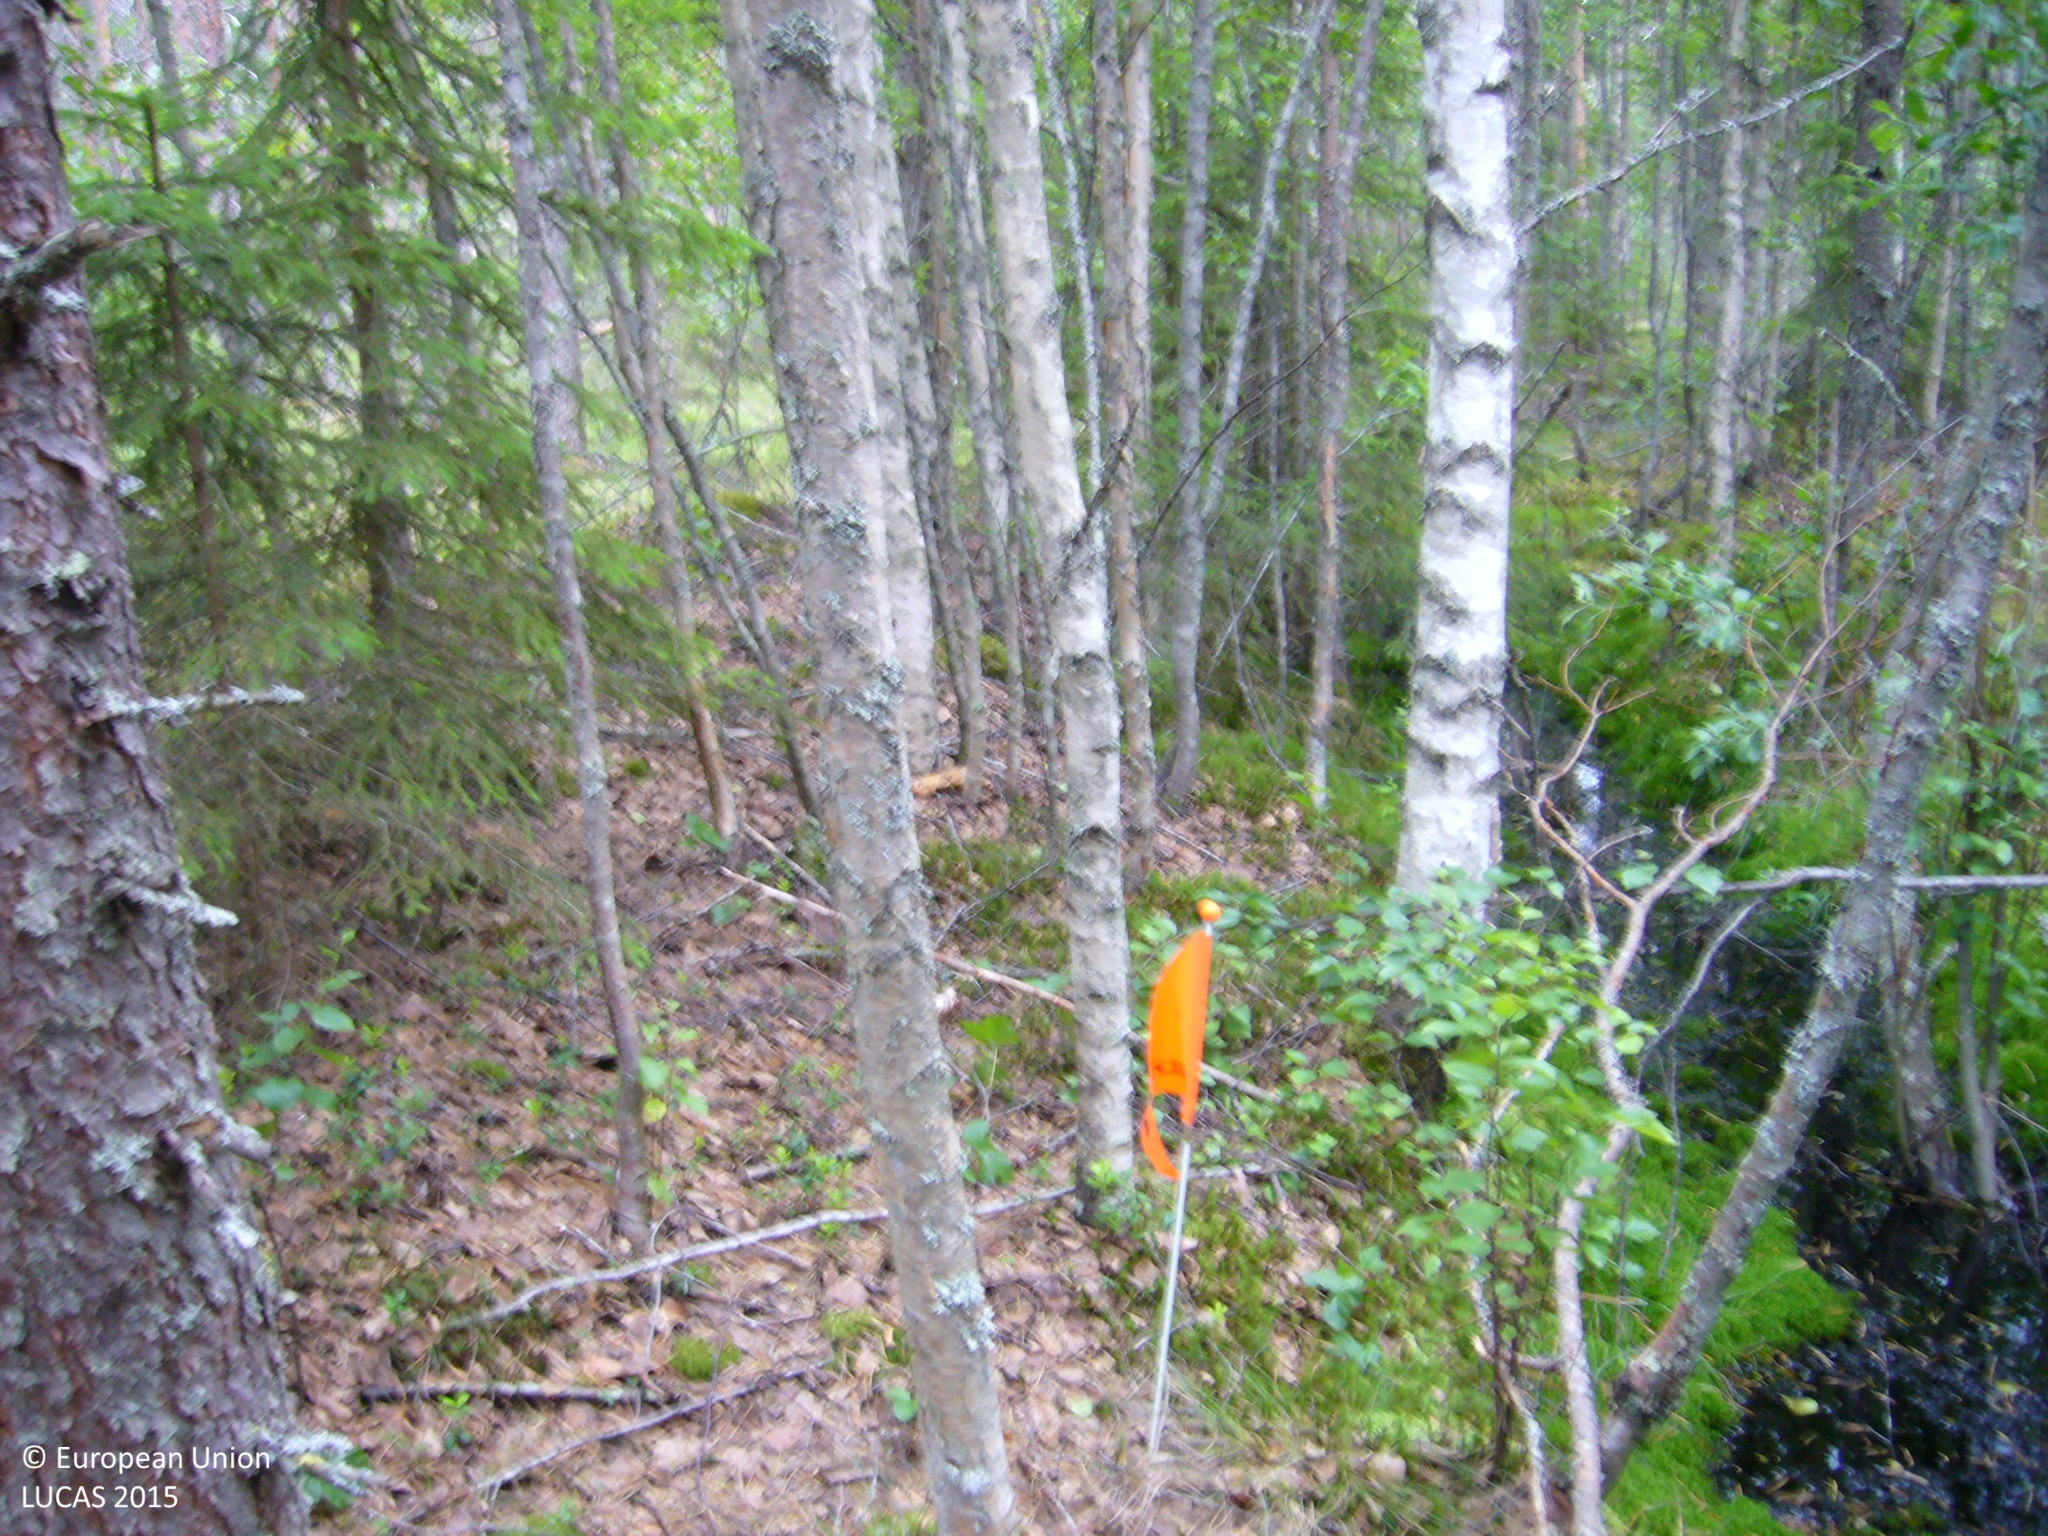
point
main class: Woodland
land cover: Other mixed woodland
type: boreal forest
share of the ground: > 75 %
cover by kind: coniferous forest trees 40 %, broadleaved forest trees 35 %, shrubs 25 %
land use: Forestry
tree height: > 5 m
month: July
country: FI
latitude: 63.2694
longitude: 26.1209
